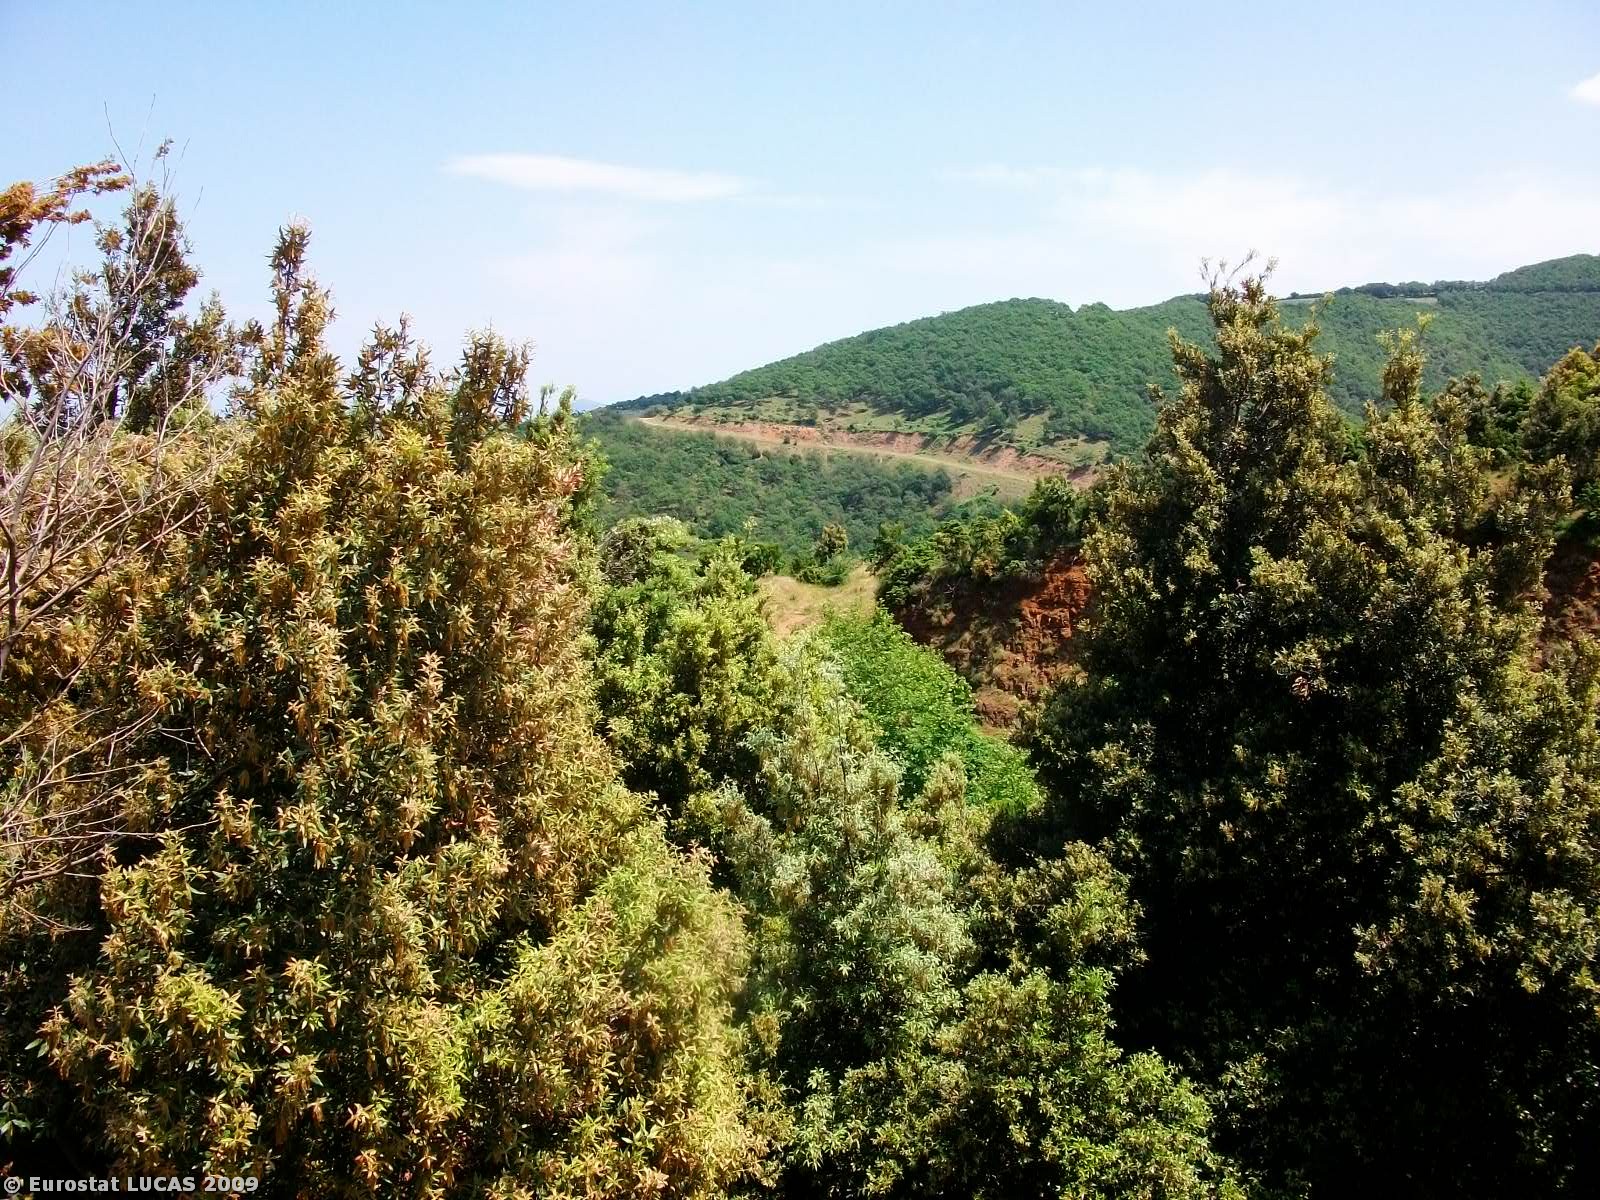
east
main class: Woodland
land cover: Mixed woodland
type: mesophytic deciduous forest
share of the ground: > 75 %
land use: Forestry
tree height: > 5 m
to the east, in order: Mixed woodland; Paved roads, cycling and walking lanes; Grassland without tree/shrub cover; Mixed woodland
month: May
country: GR
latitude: 39.0858
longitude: 22.7372
